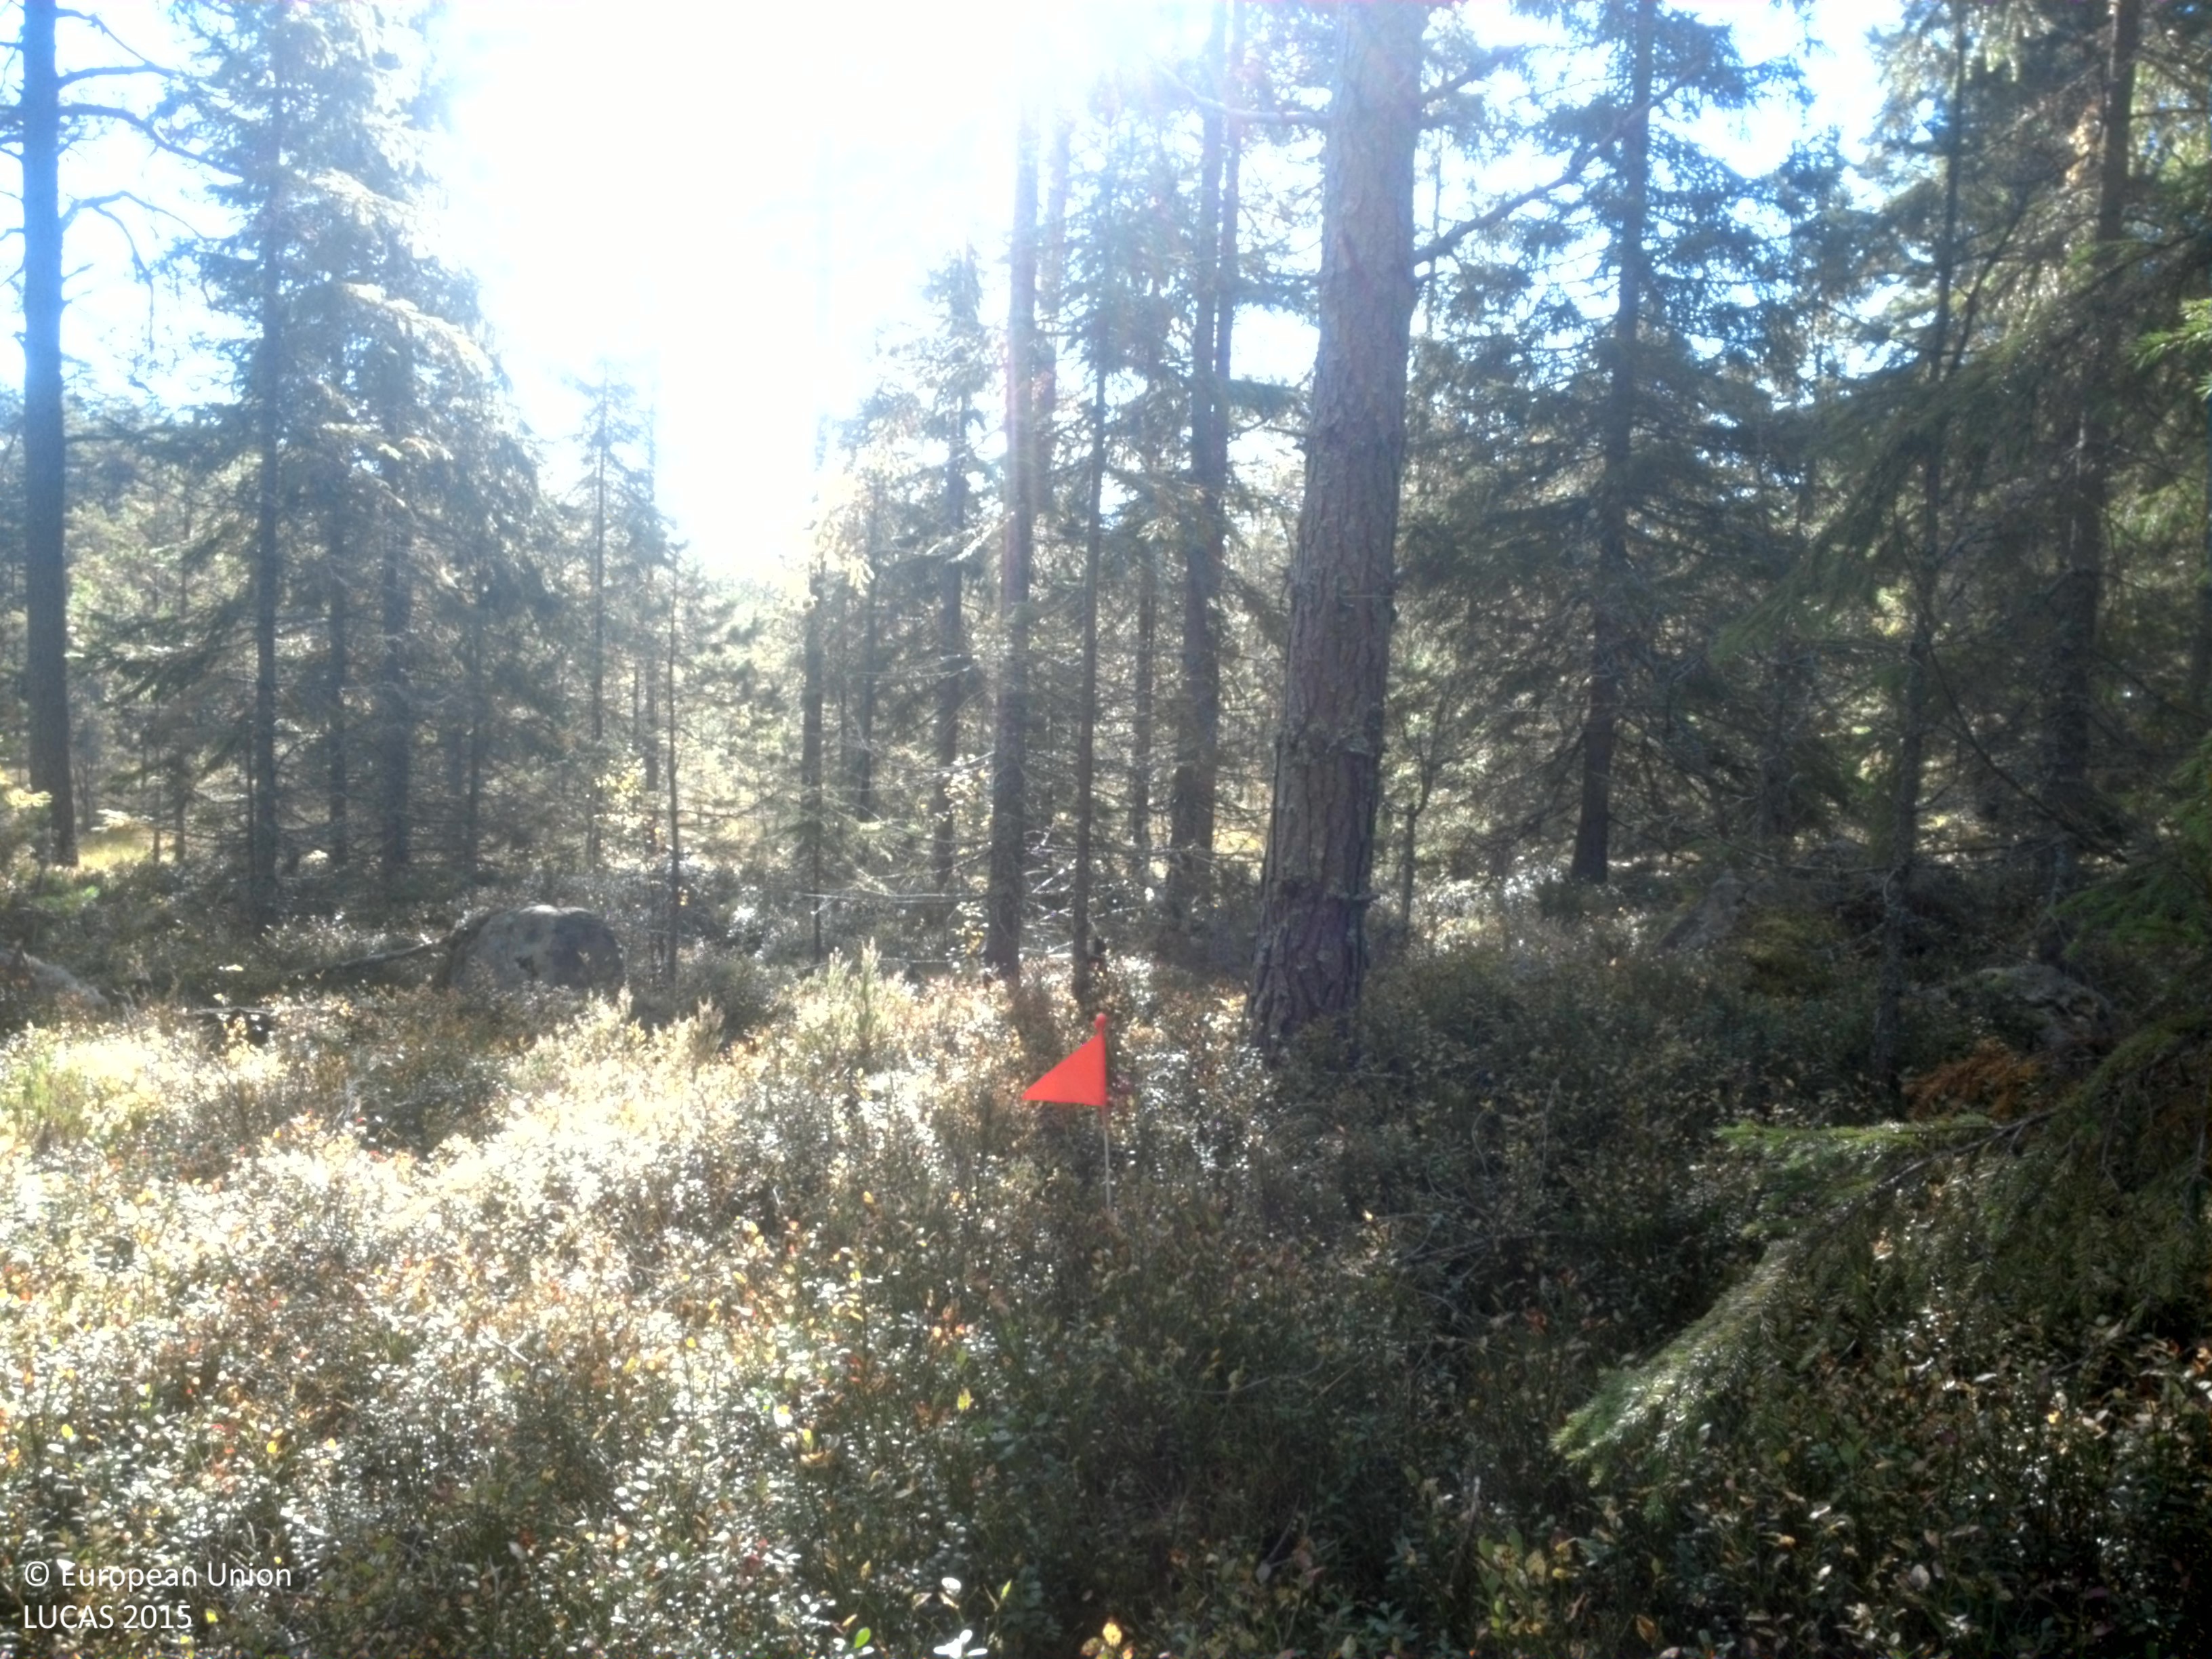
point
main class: Woodland
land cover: Other coniferous woodland
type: boreal forest
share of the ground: > 75 %
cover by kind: coniferous forest trees 75 %, shrubs 20 %, lichens and mosses 5 %
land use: Forestry
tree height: > 5 m
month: September
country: SE
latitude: 59.8688
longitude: 15.1869
